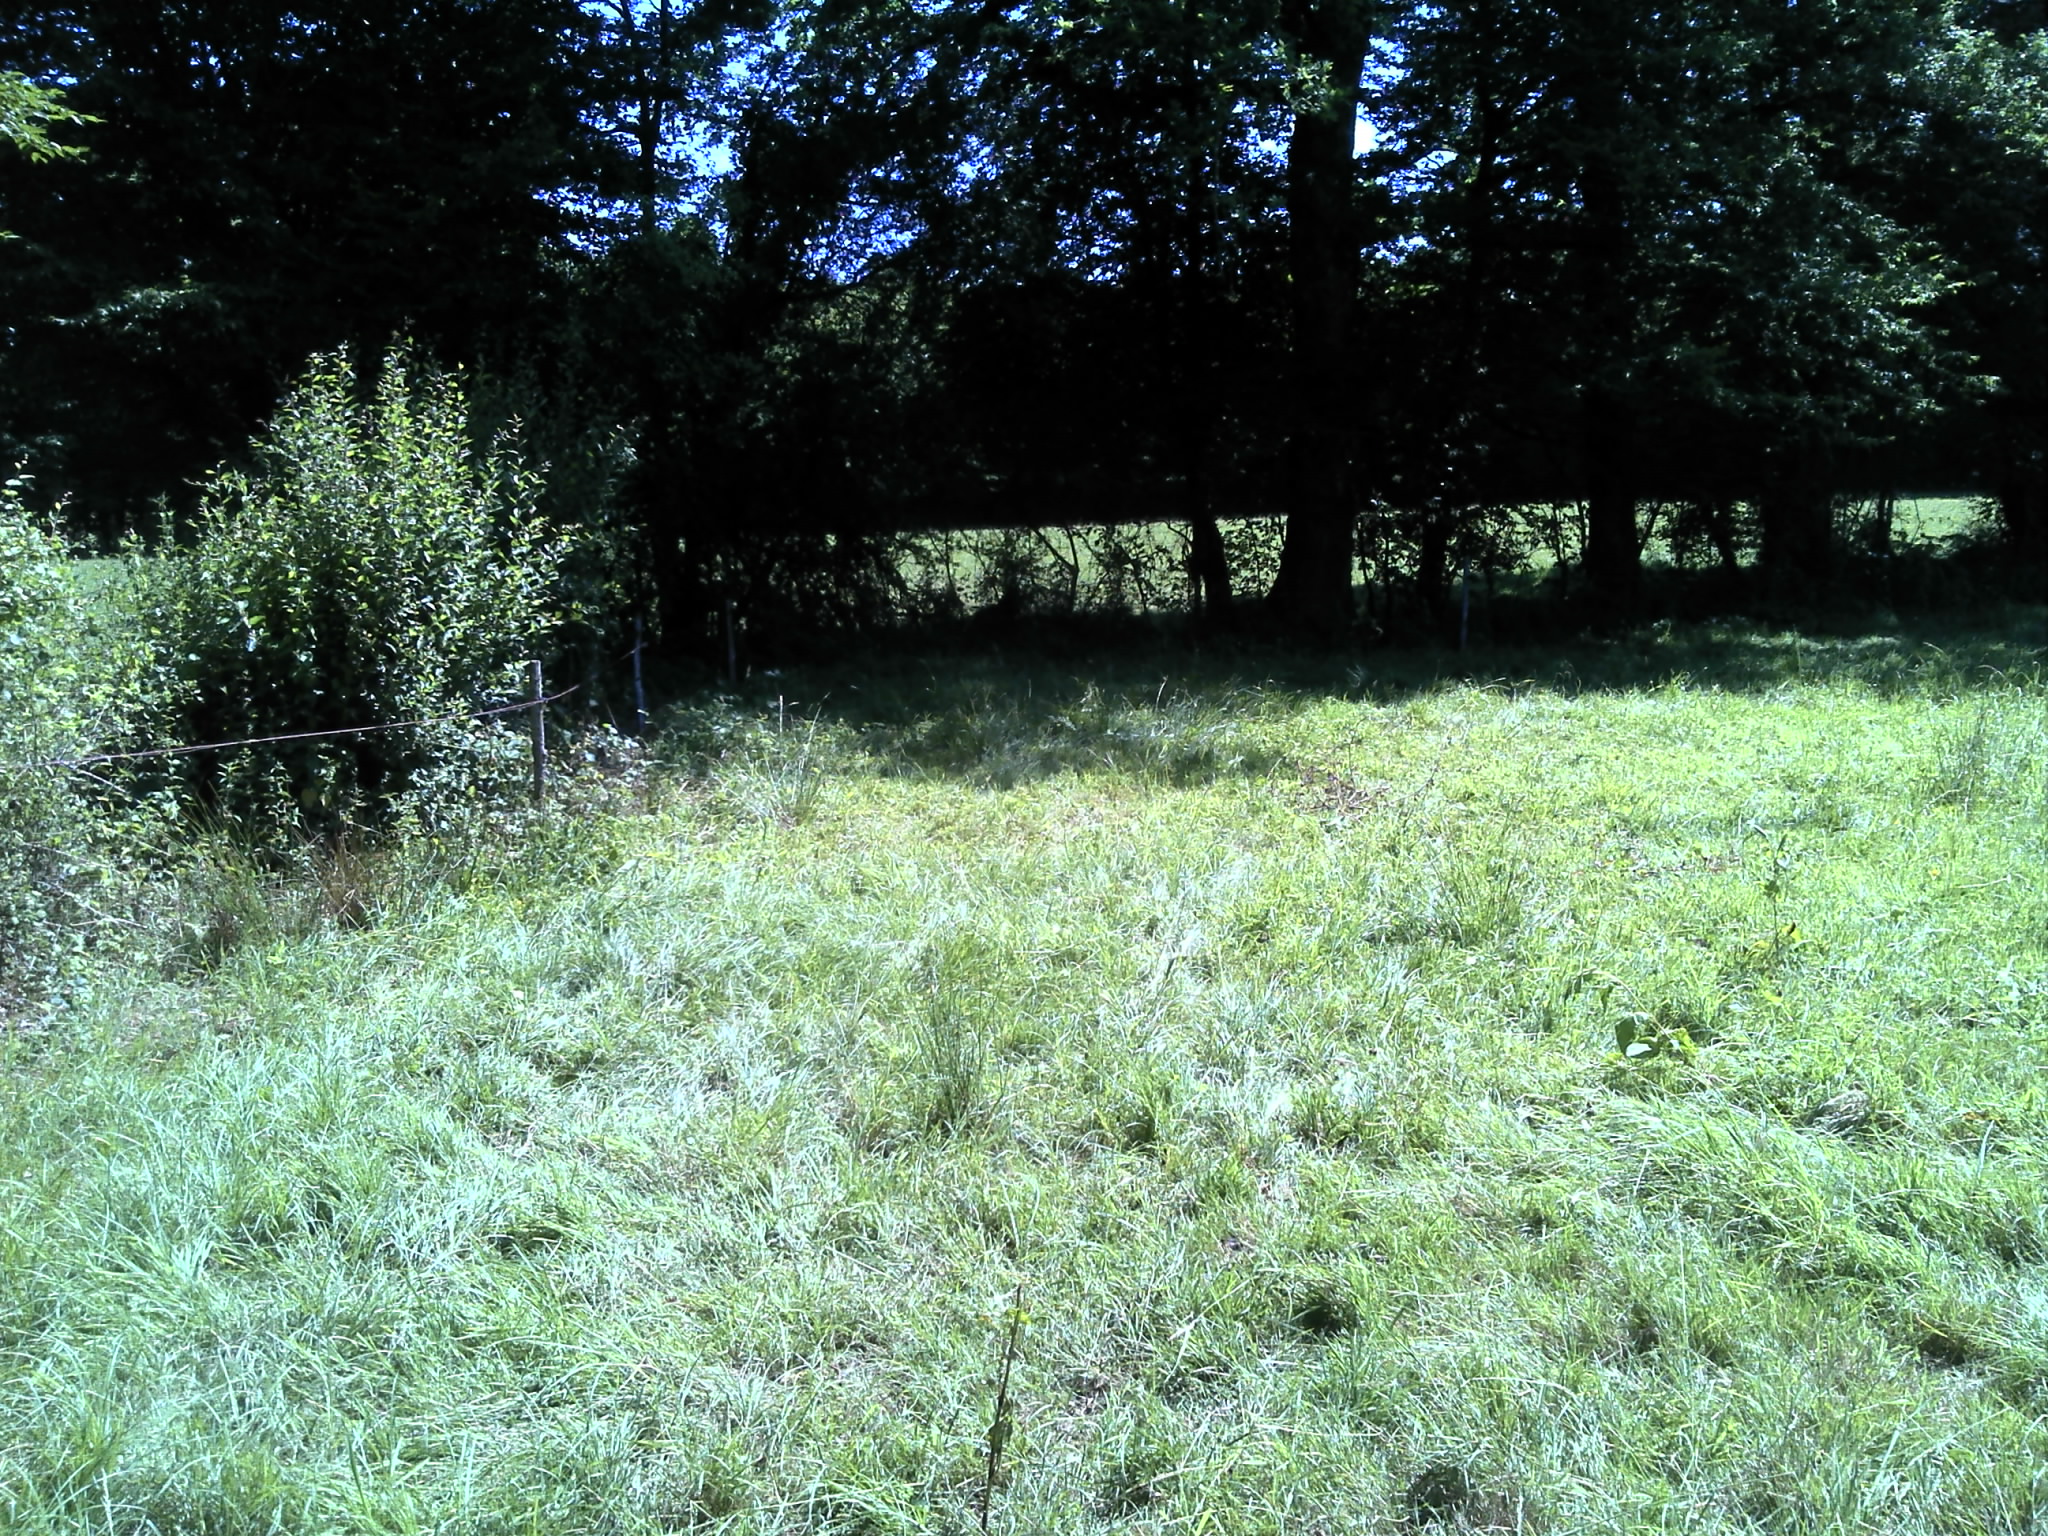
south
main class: Grassland
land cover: Grassland without tree/shrub cover
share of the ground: > 75 %
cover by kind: herbaceous plants 100 %
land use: Agriculture (excluding fallow land and kitchen gardens)
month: June
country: FR
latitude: 46.3966
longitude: 1.5497
